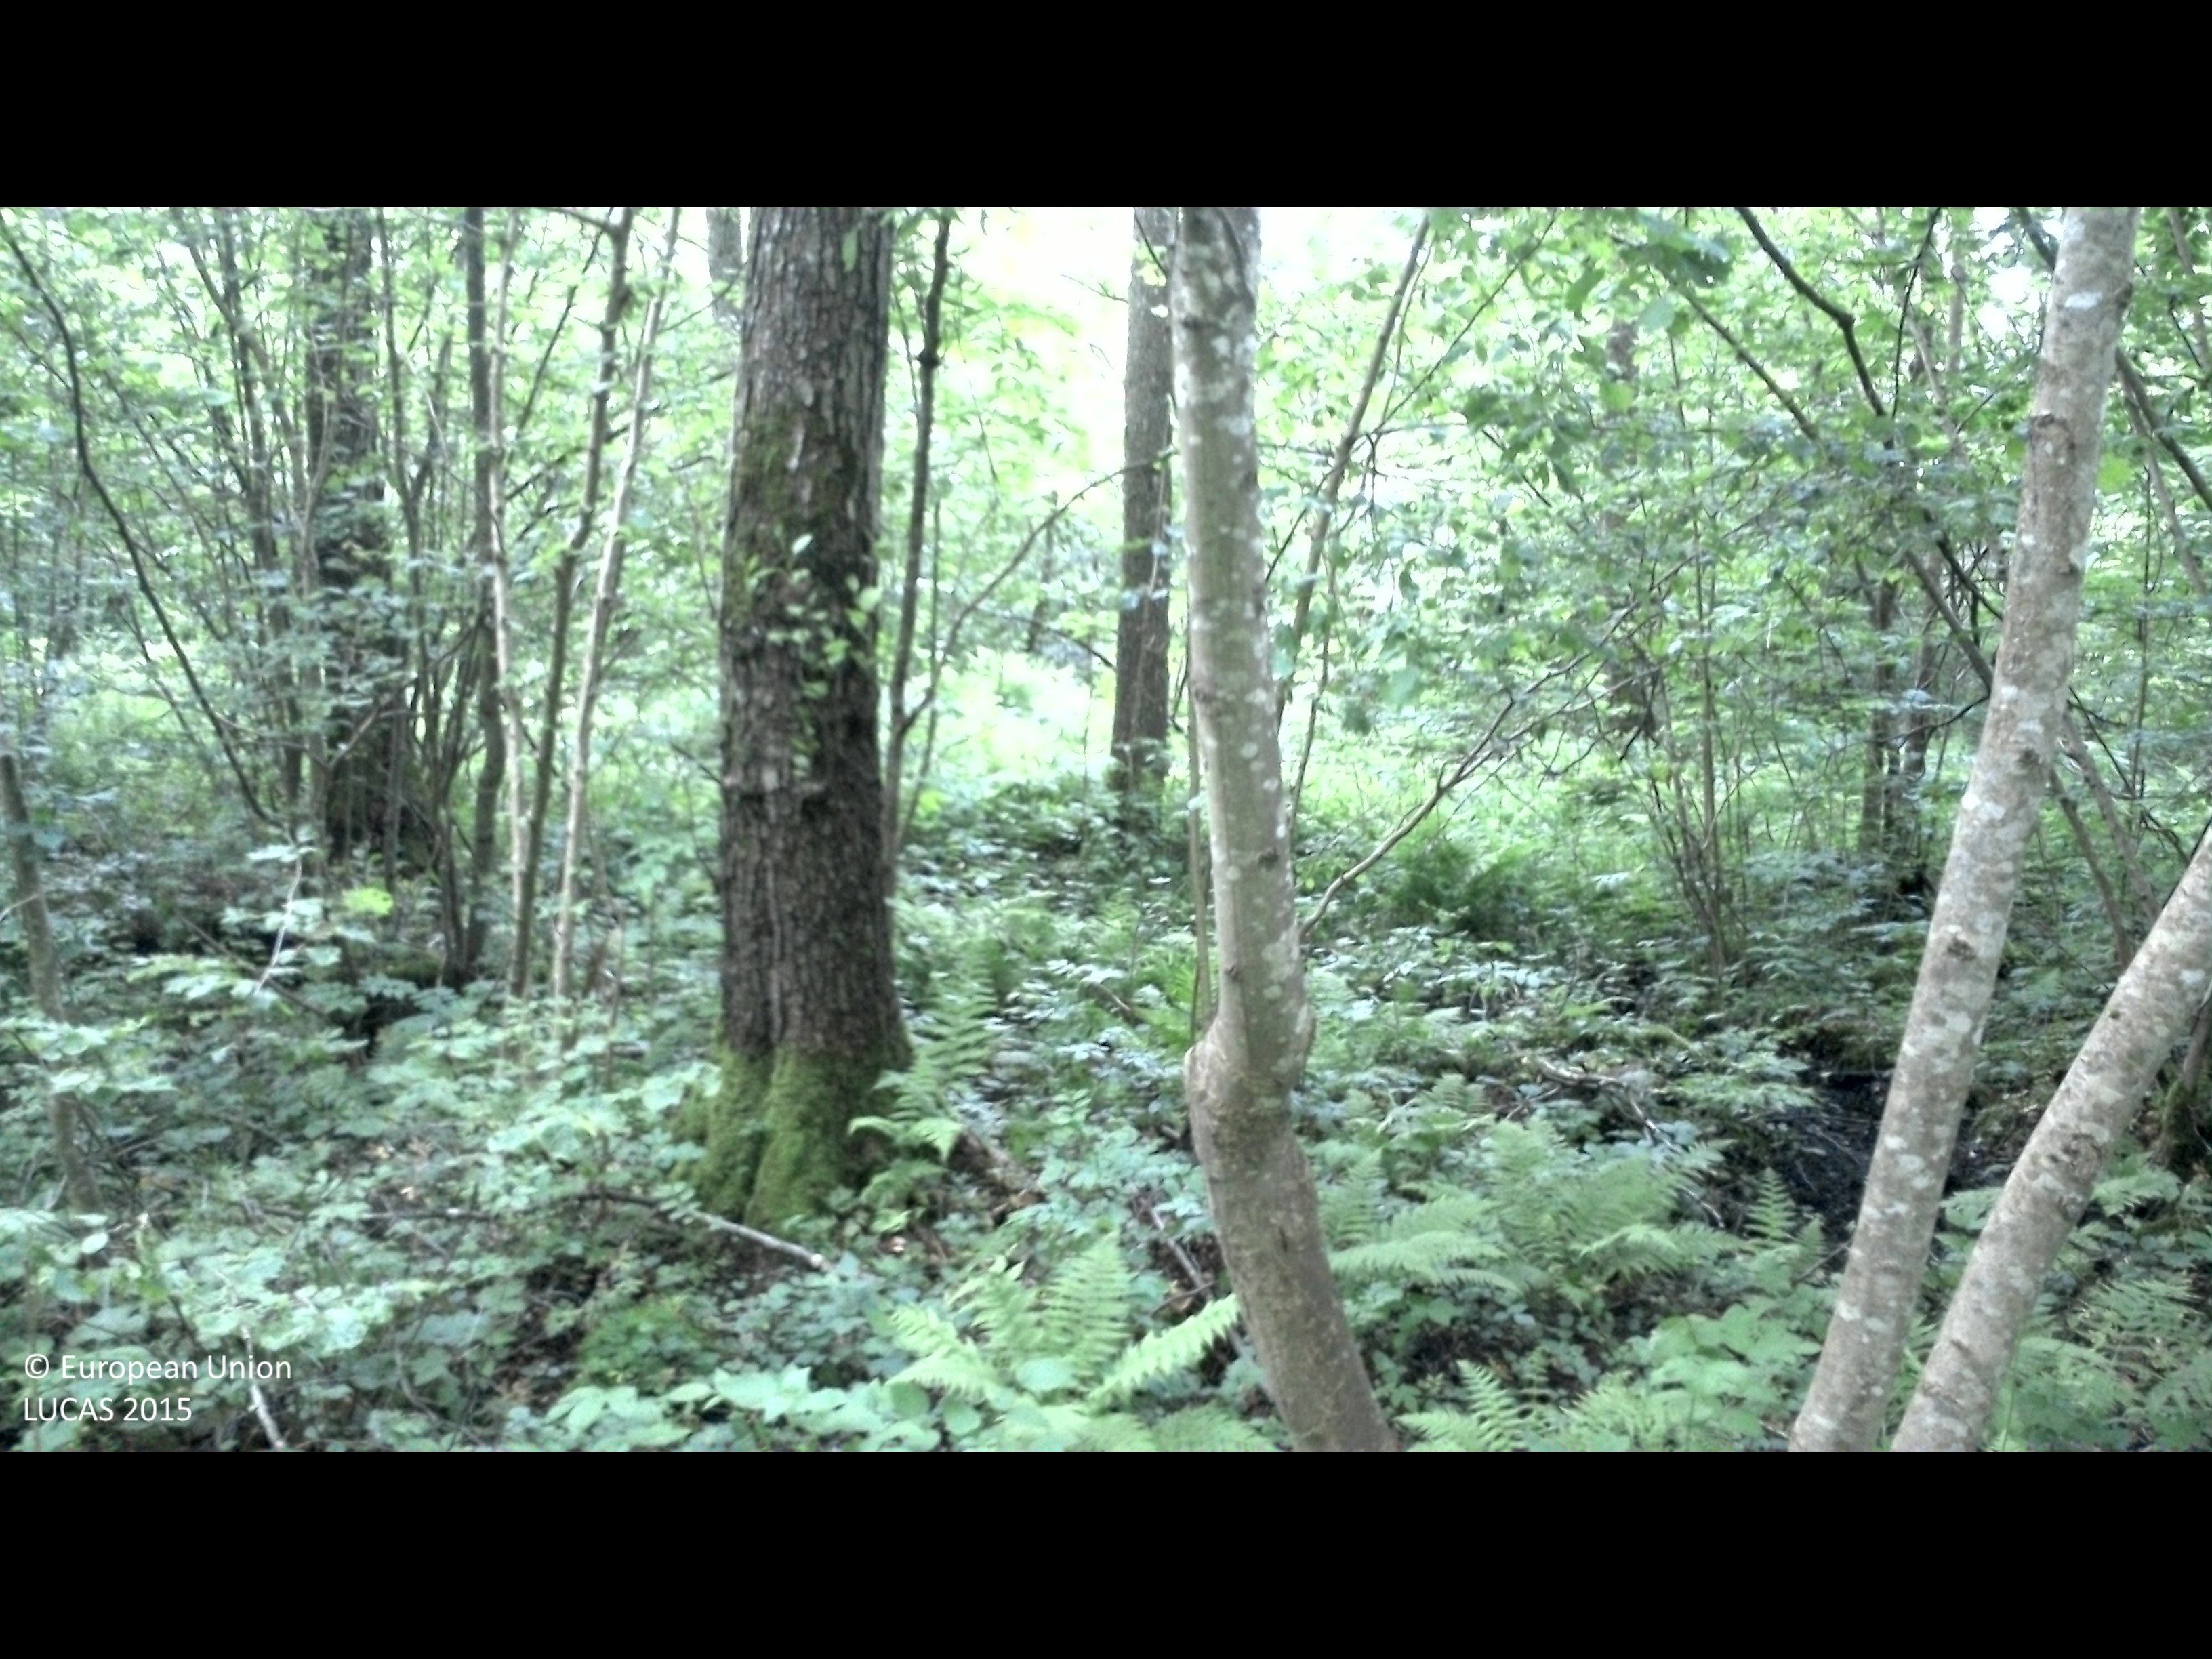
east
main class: Woodland
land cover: Broadleaved woodland
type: hemiboreal forest and nemoral coniferous forest and mixed broadleaved-coniferous forest
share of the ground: 50 - 75 %
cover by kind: broadleaved forest trees 65 %, shrubs 30 %, herbaceous plants 5 %
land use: Forestry
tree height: > 5 m
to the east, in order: Broadleaved woodland; Tracks; Broadleaved woodland
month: June
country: SE
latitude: 56.1782
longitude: 14.0410
